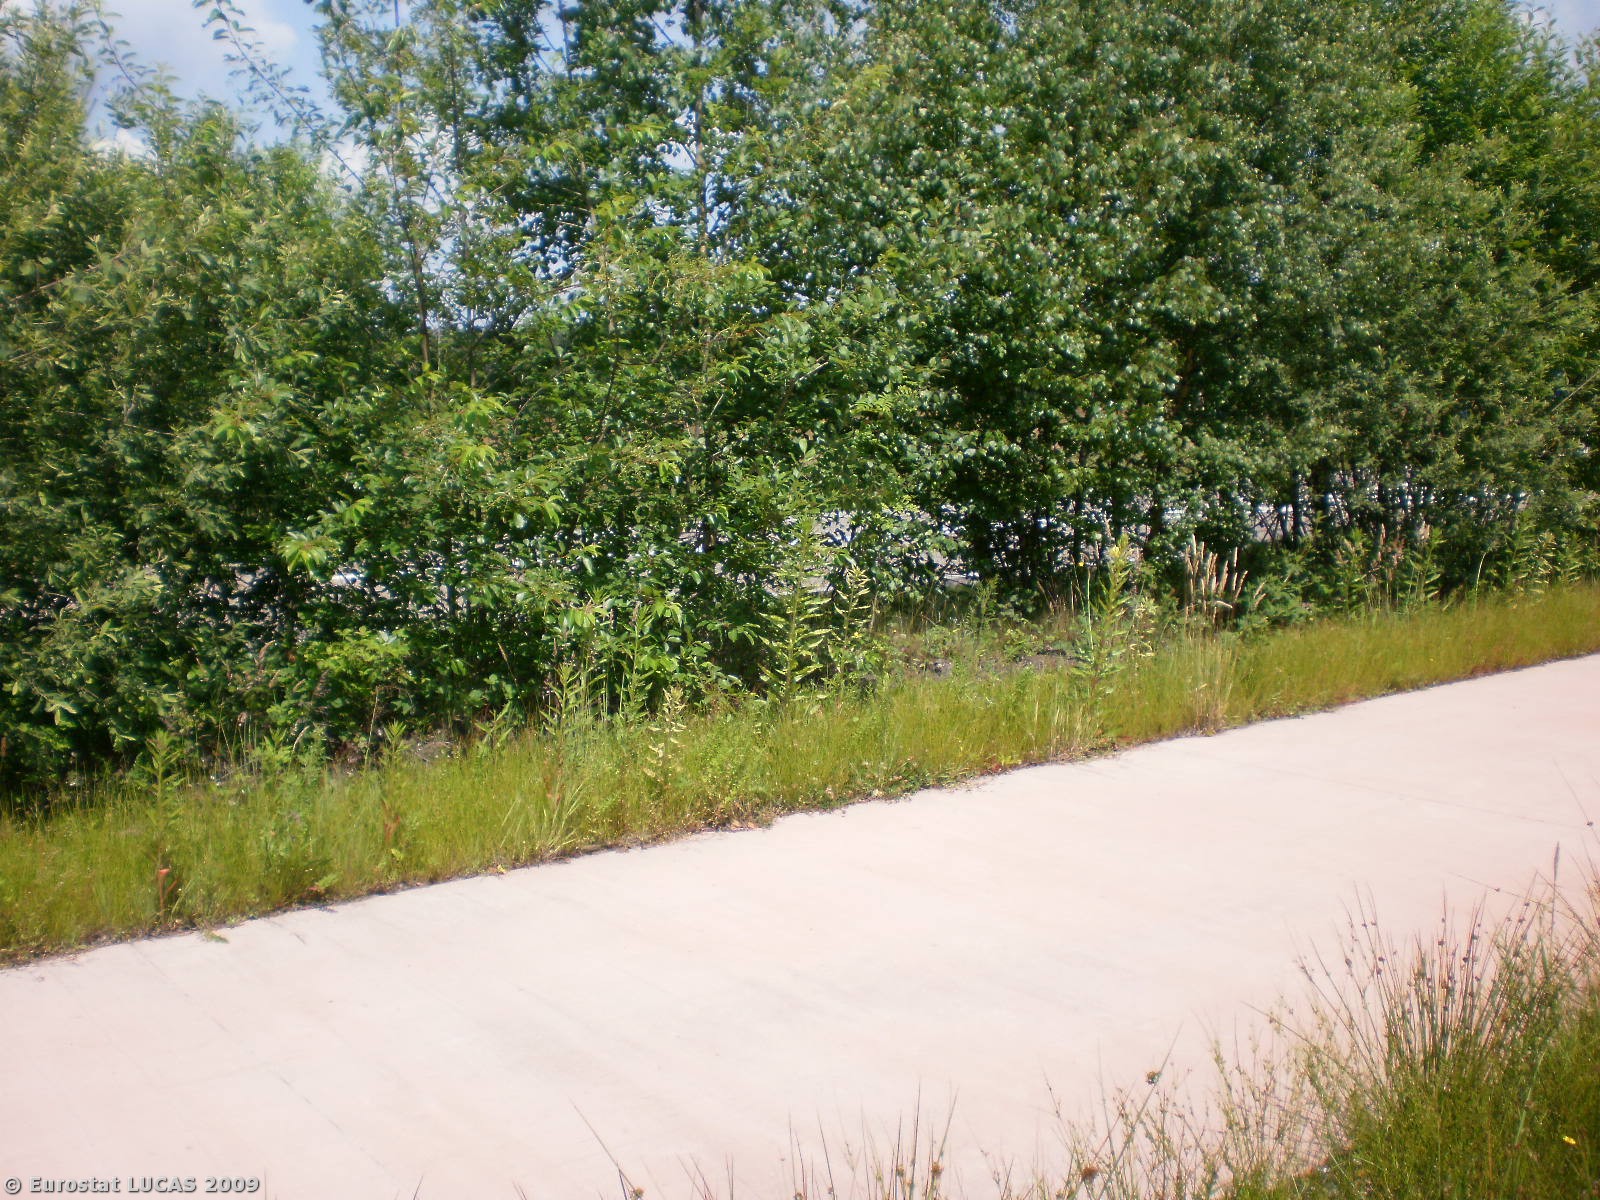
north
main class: Grassland
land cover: Grassland without tree/shrub cover
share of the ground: > 75 %
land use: Unused
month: June
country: BE
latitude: 50.9940
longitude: 5.4530
